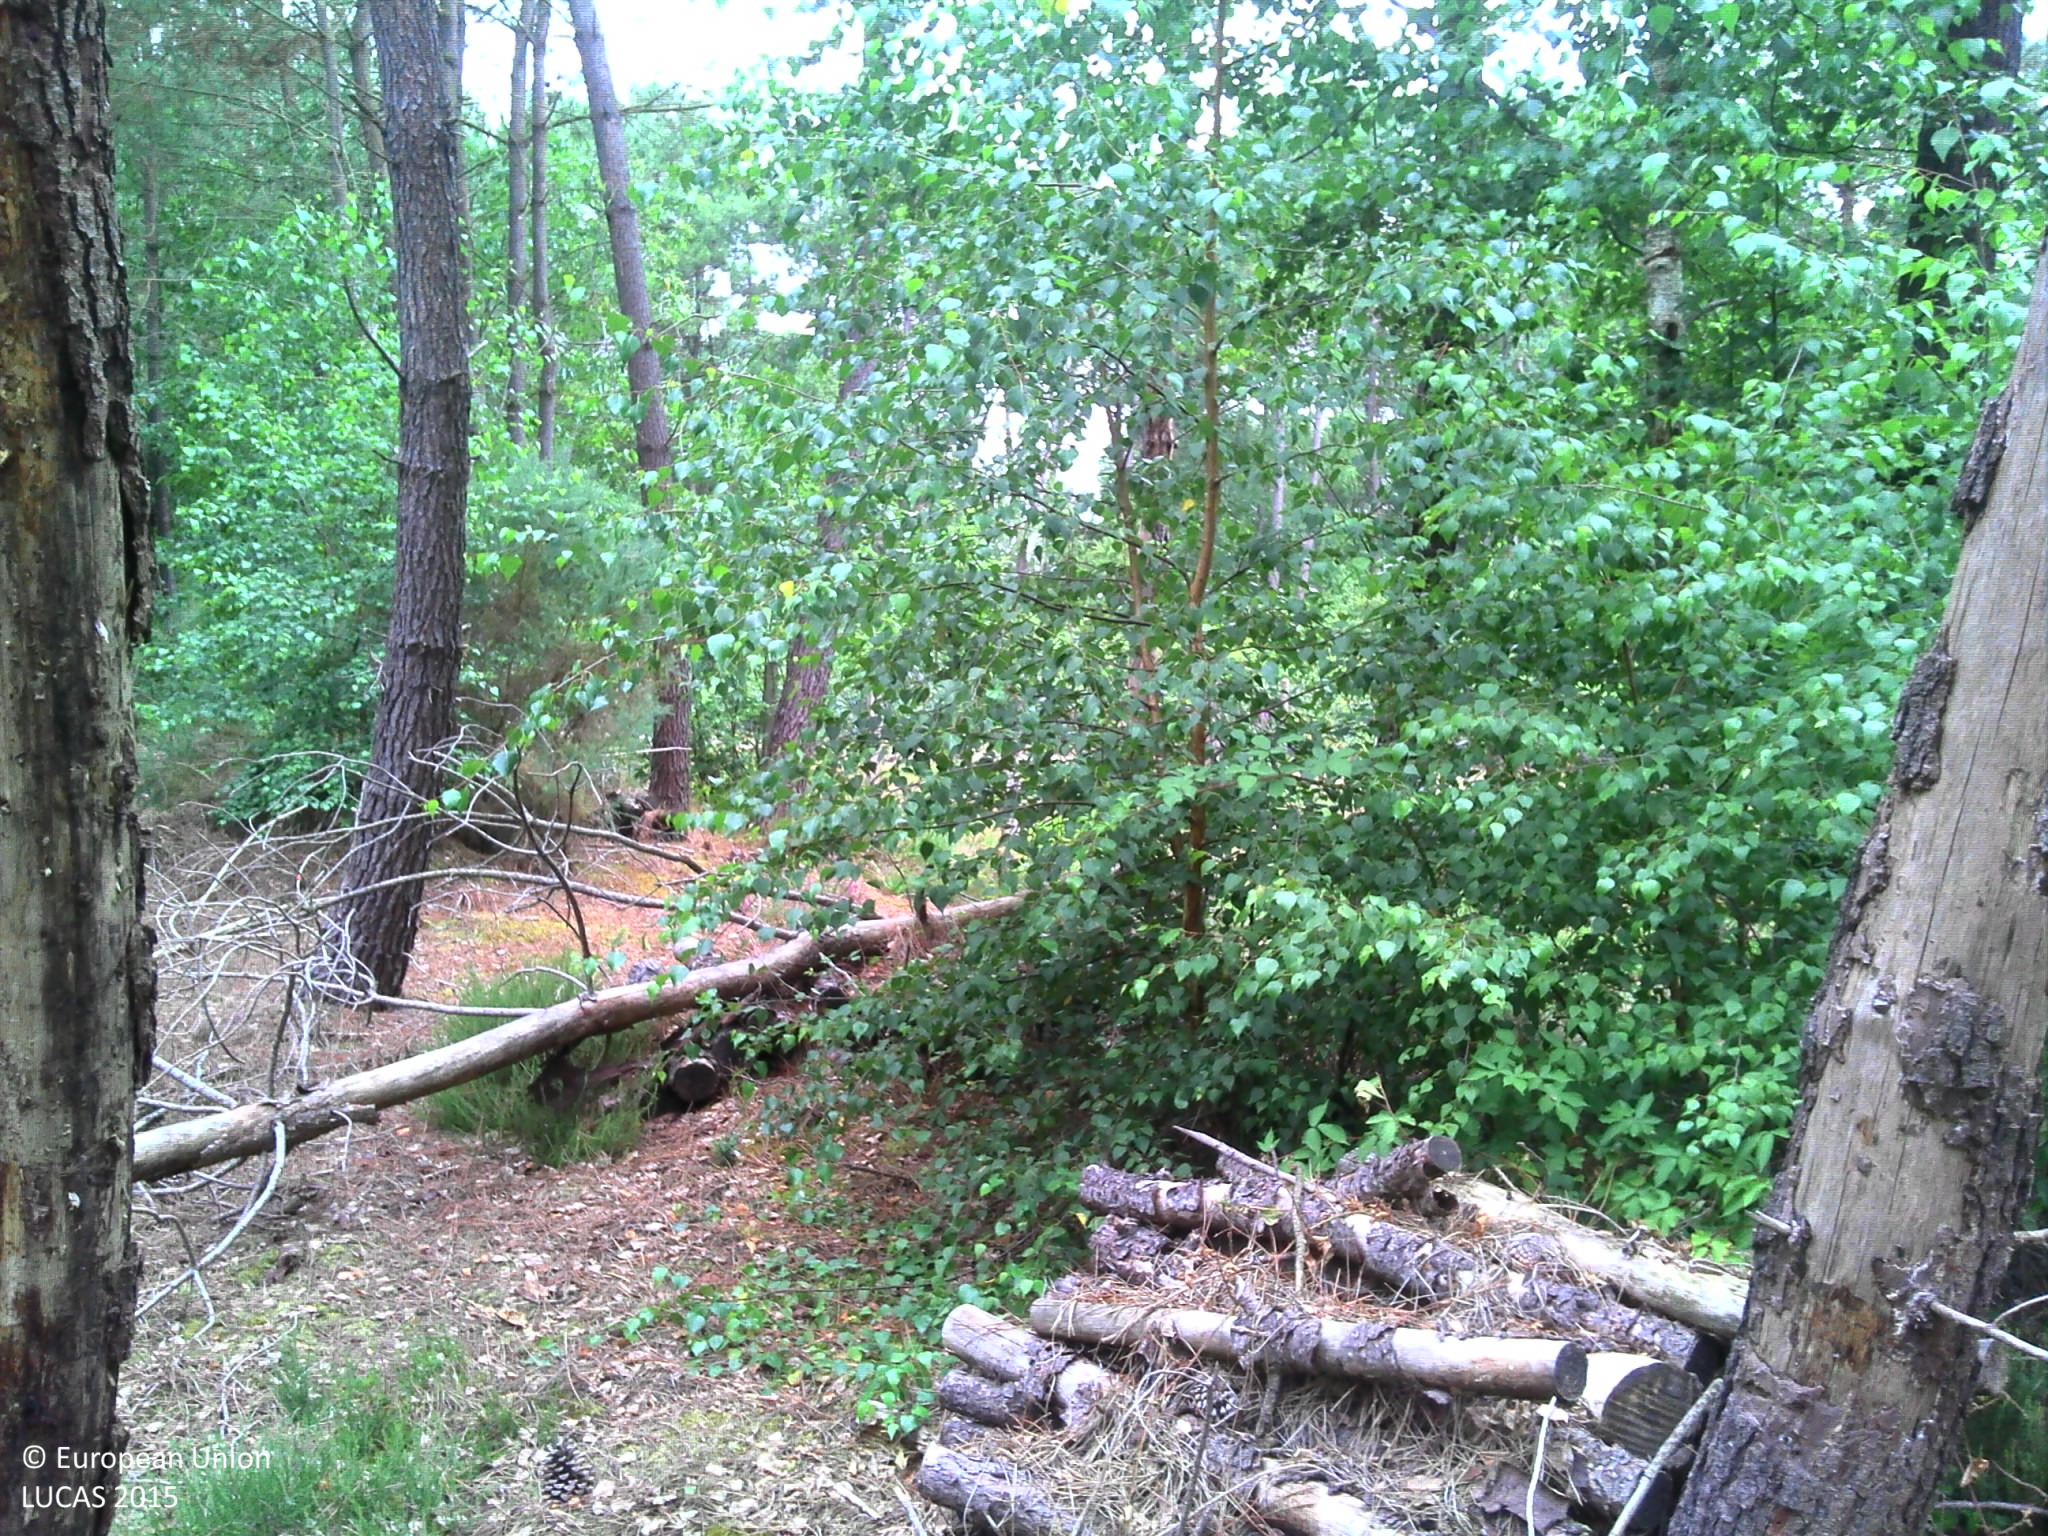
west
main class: Woodland
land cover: Pine dominated coniferous woodland
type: exotic forest
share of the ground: > 75 %
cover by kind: coniferous forest trees 60 %, herbaceous plants 30 %, shrubs 10 %
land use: Forestry
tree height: > 5 m
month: July
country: FR
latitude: 47.8884
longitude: 0.3331
